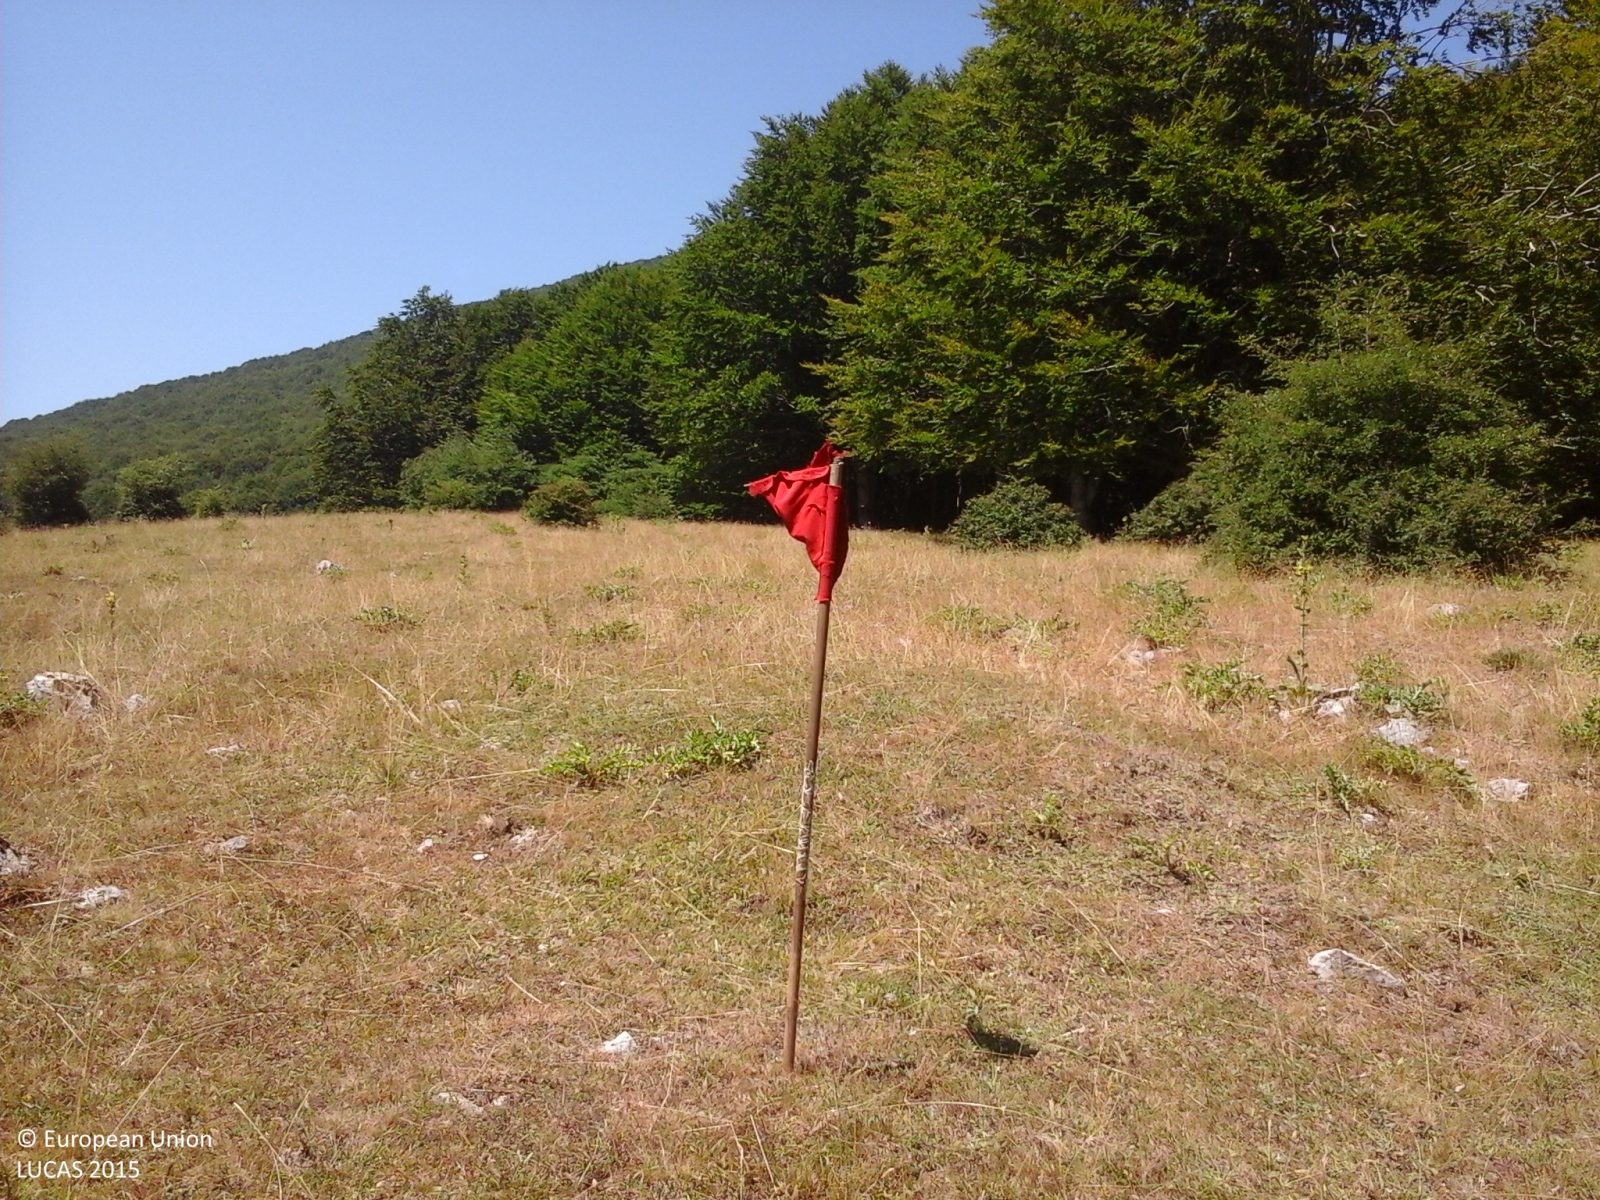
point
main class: Grassland
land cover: Grassland without tree/shrub cover
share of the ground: > 75 %
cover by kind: herbaceous plants 100 %
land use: Agriculture (excluding fallow land and kitchen gardens)
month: July
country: IT
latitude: 40.7867
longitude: 15.1109
